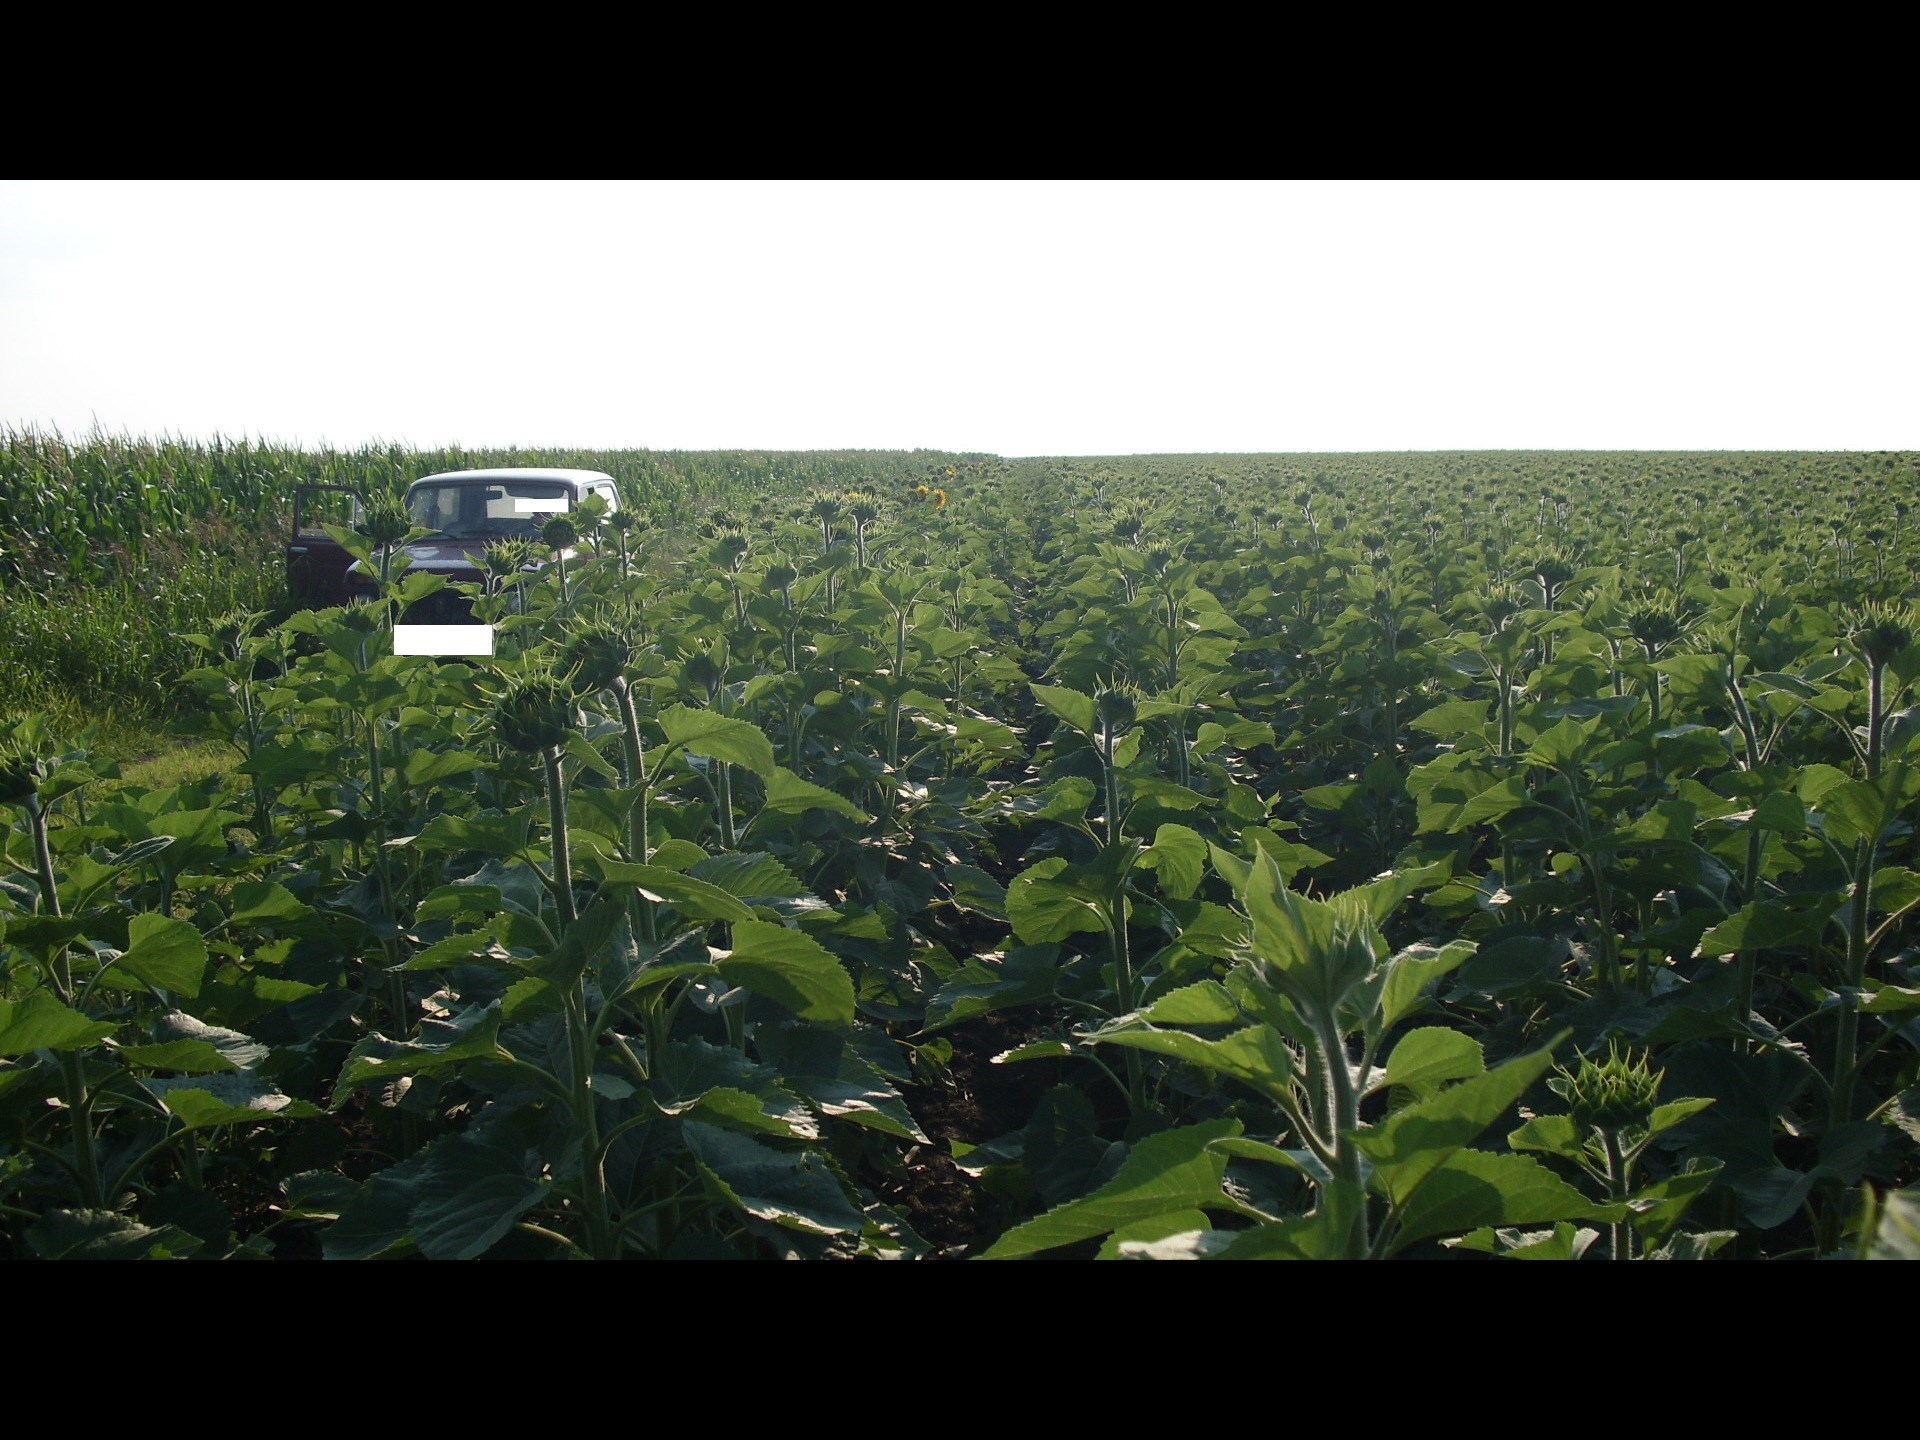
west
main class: Cropland
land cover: Sunflower
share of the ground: > 75 %
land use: Agriculture (excluding fallow land and kitchen gardens)
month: June
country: BG
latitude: 43.6902
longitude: 23.5832
